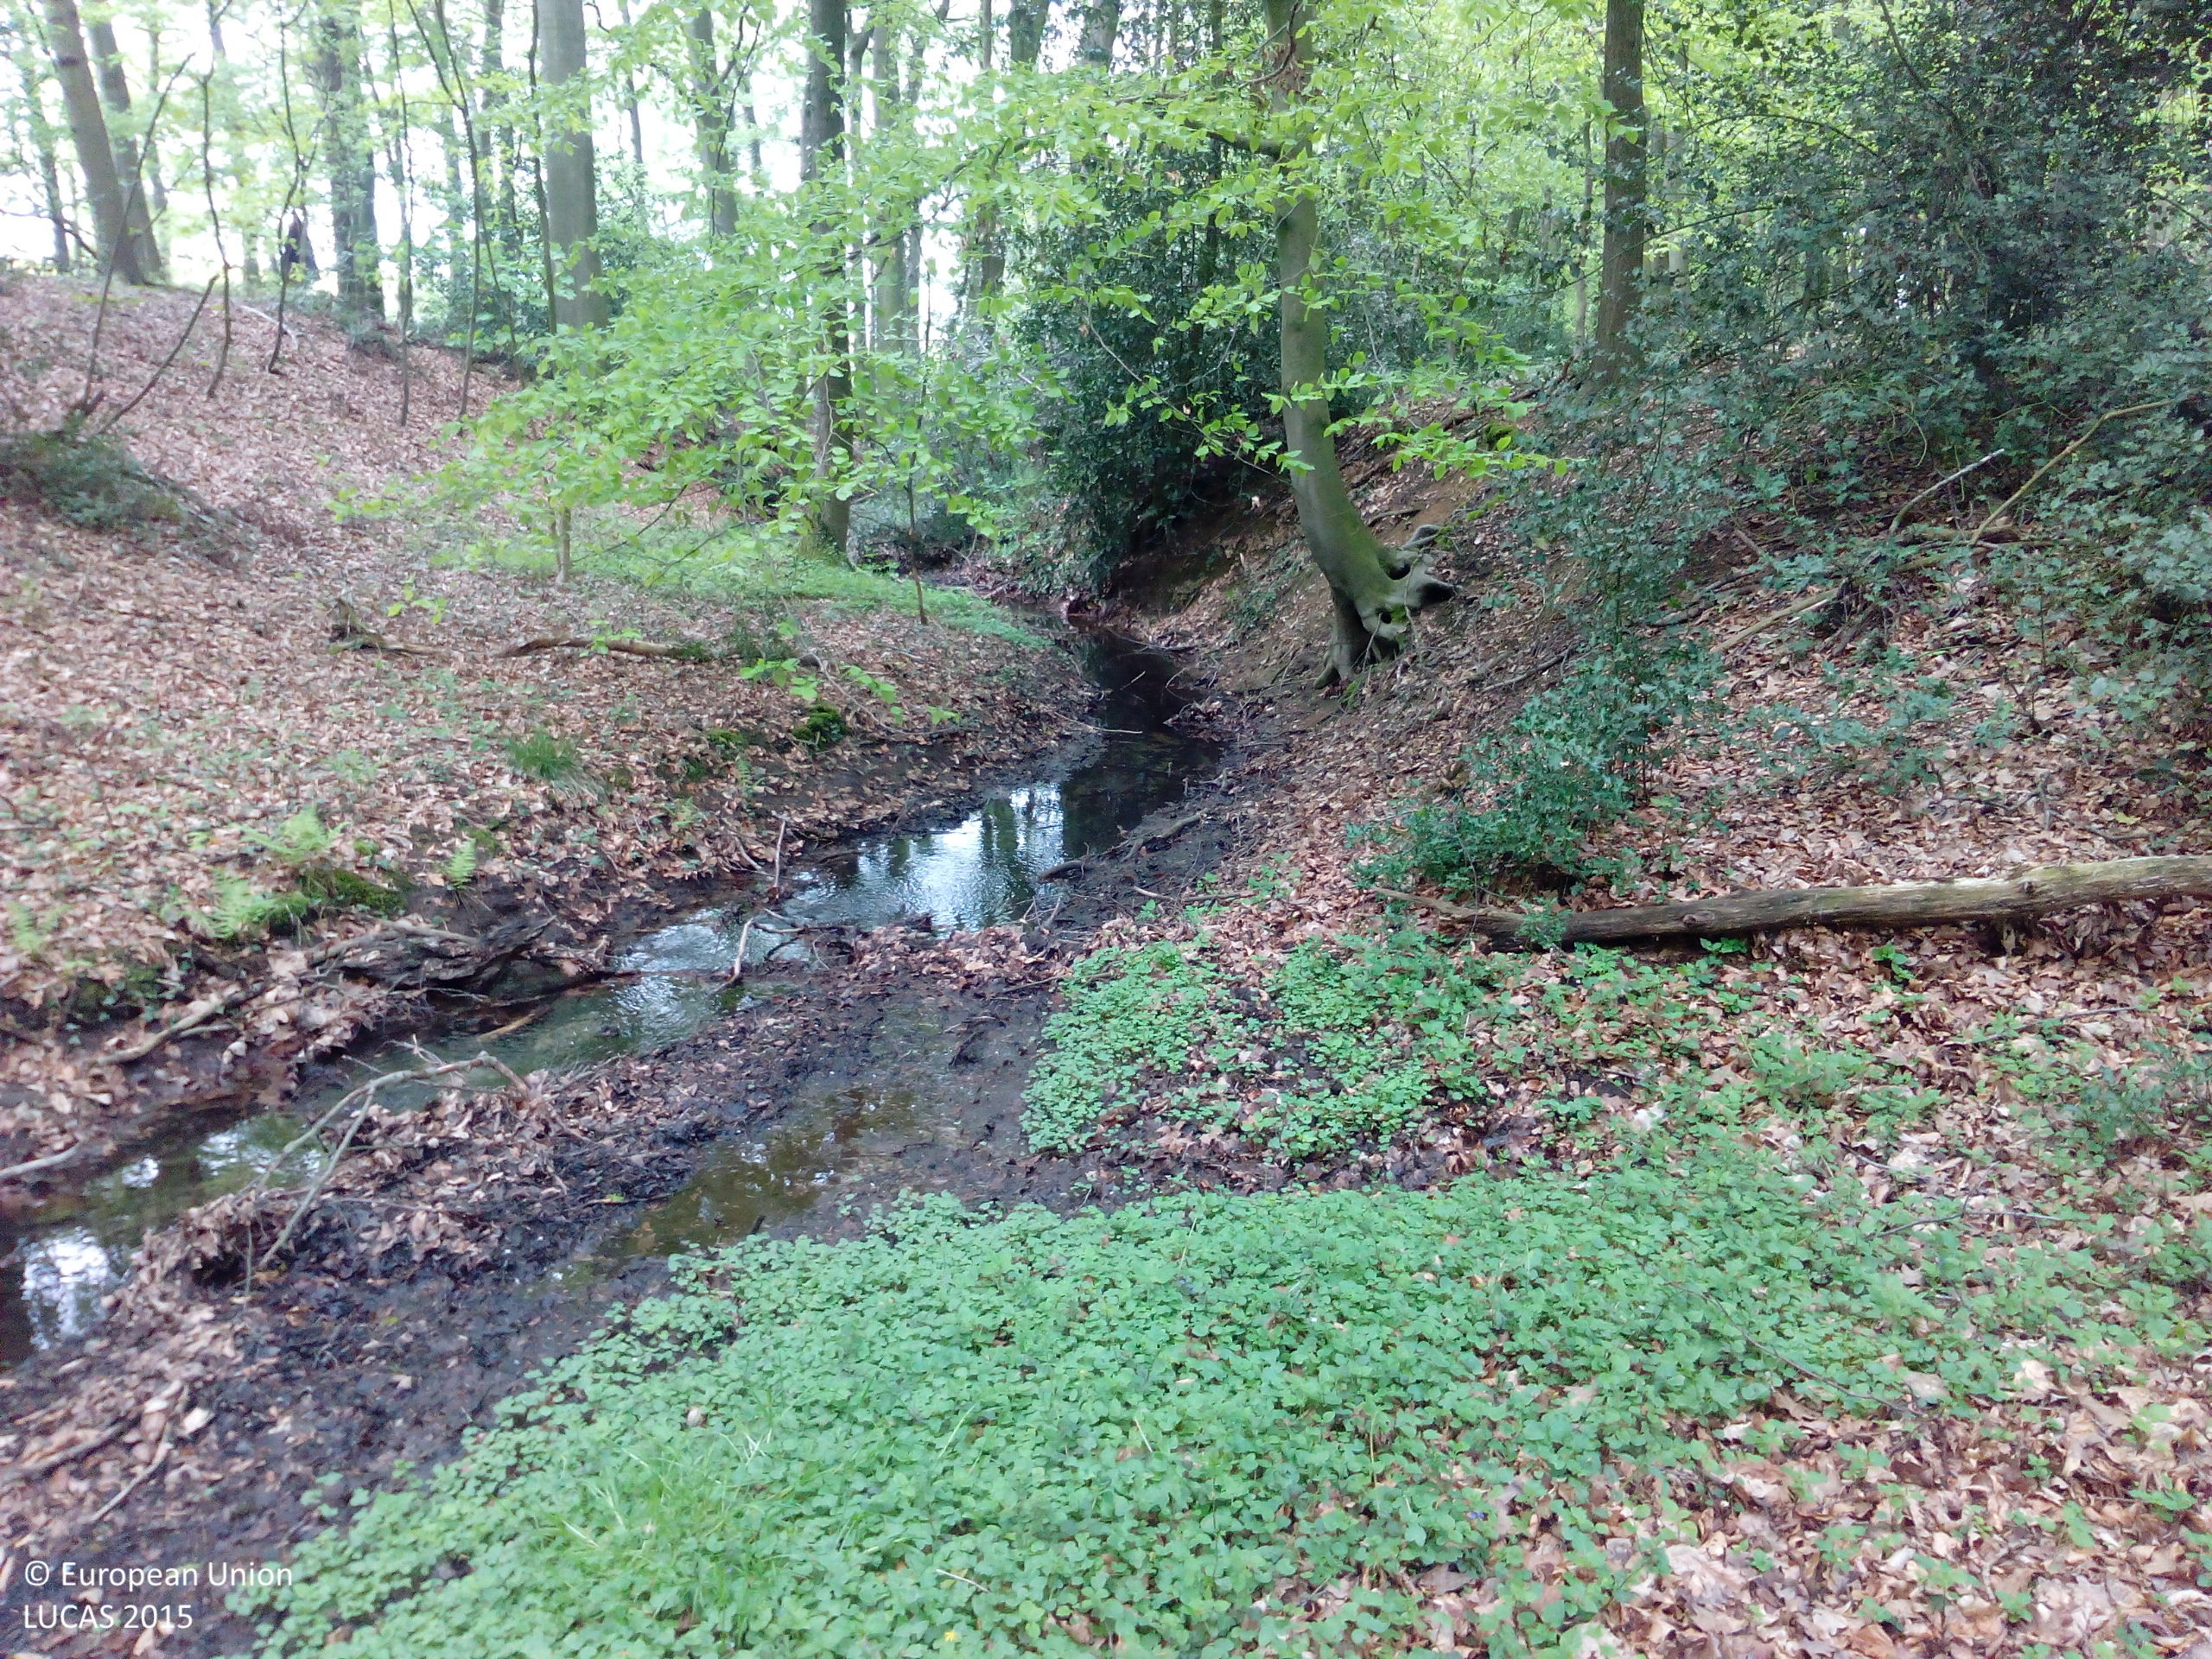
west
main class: Woodland
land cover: Broadleaved woodland
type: mesophytic deciduous forest
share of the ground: > 75 %
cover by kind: broadleaved forest trees 90 %, shrubs 5 %, unconsolidated bare surface 5 %
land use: Forestry
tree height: > 5 m
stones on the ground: < 10 %
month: May
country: DE
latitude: 51.6659
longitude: 7.4122
